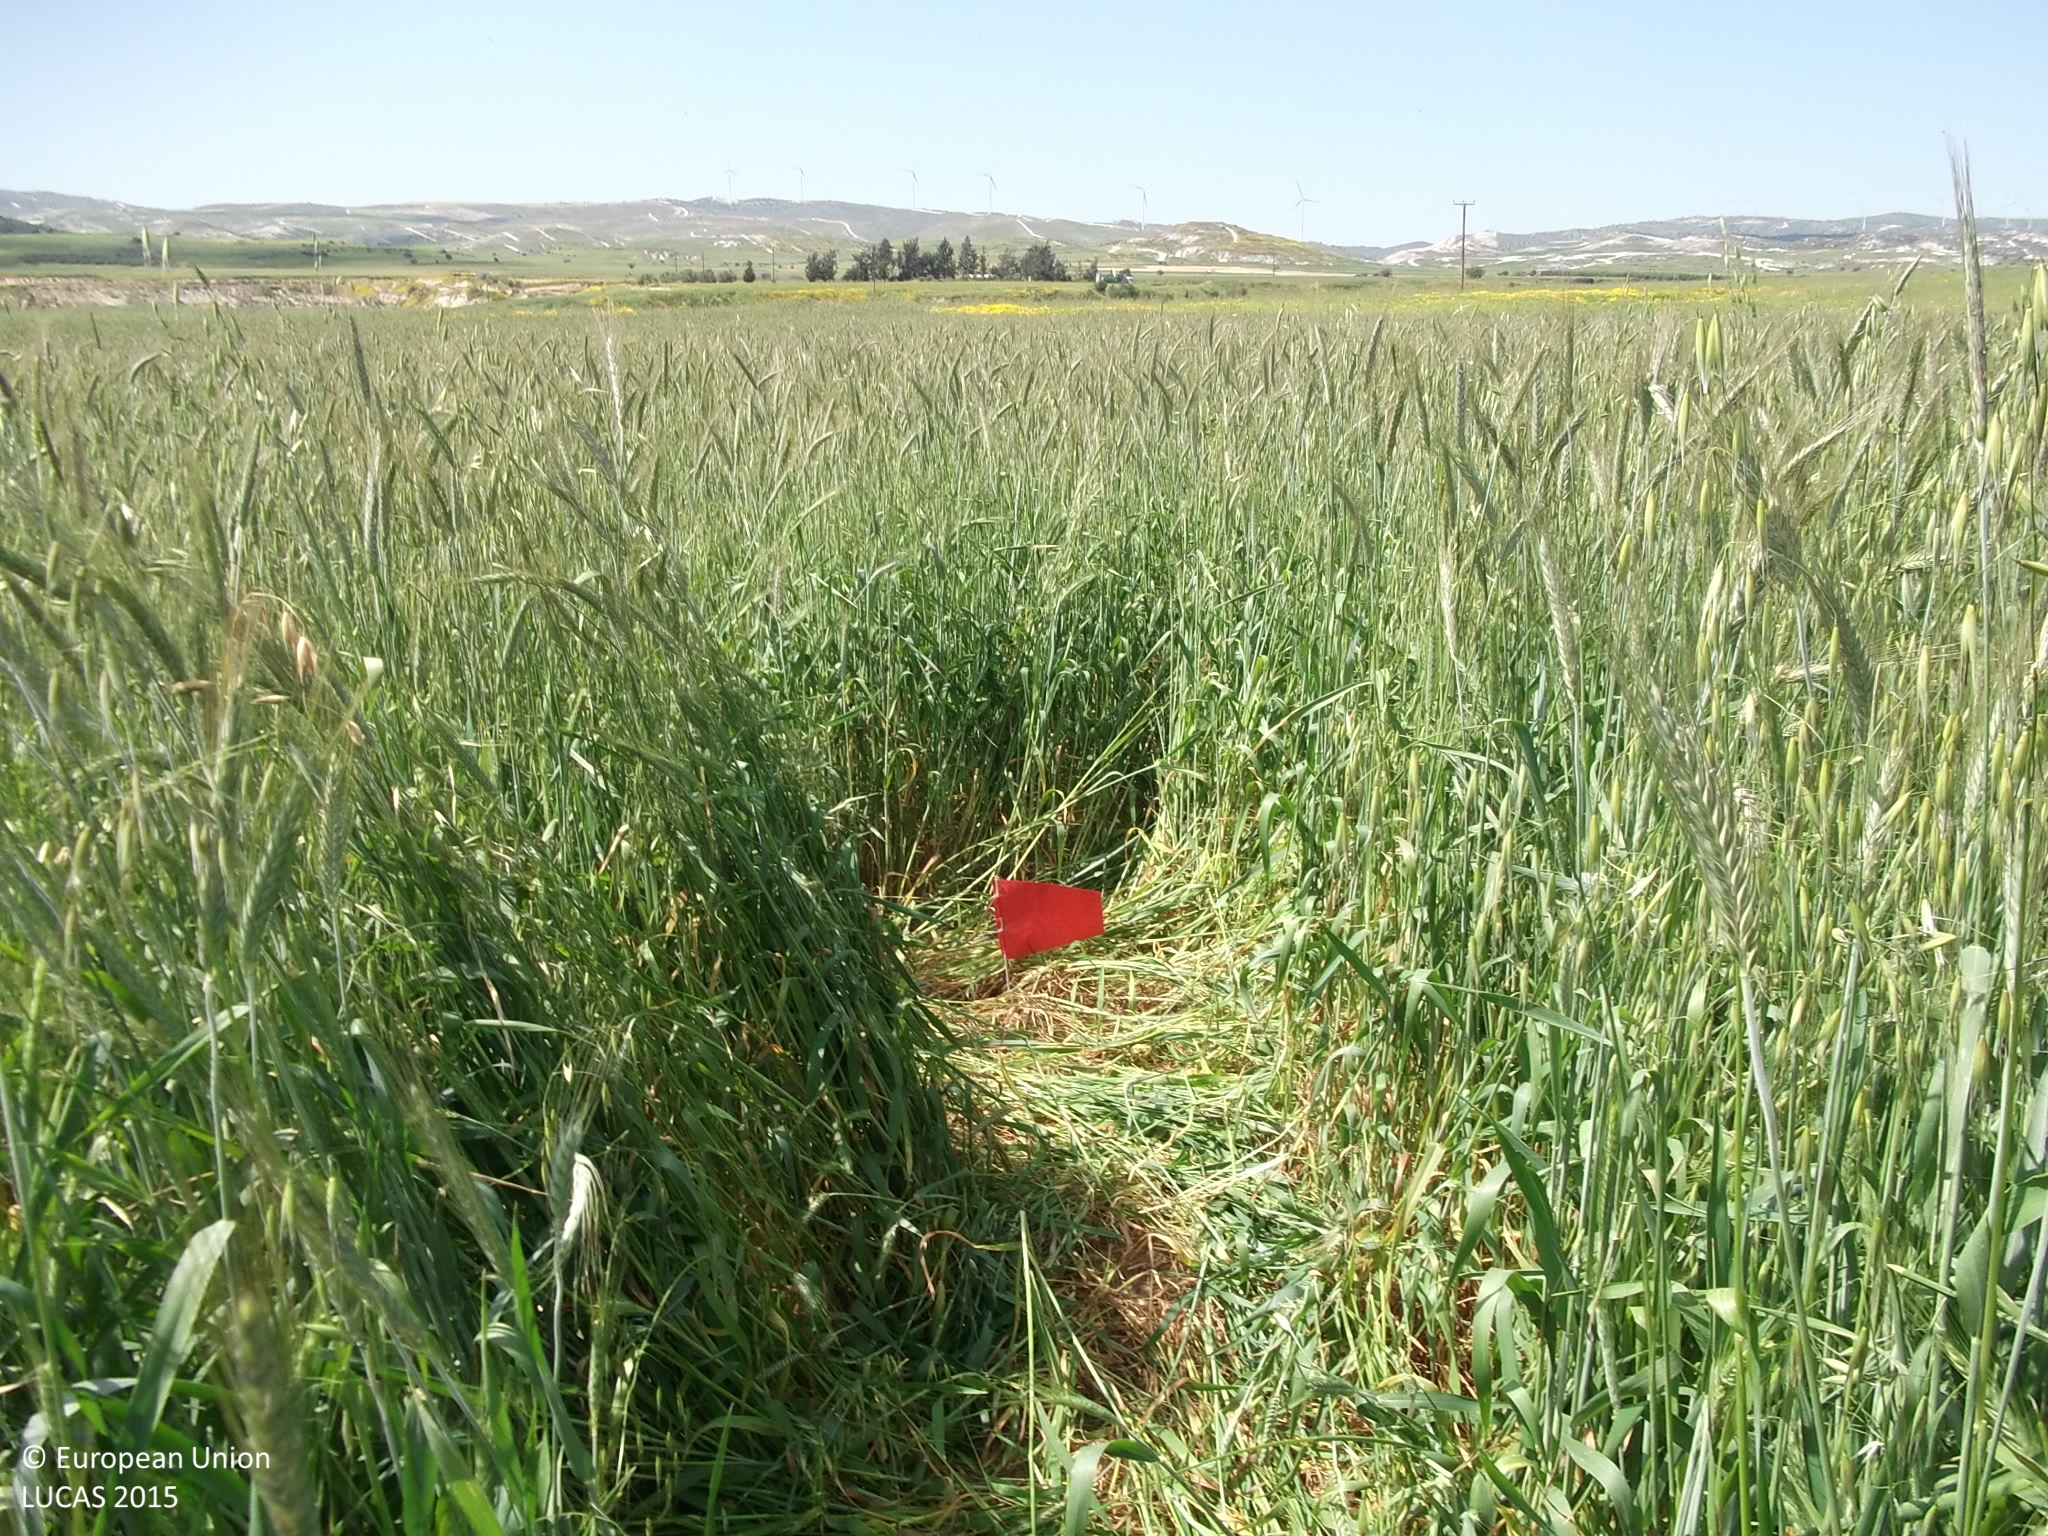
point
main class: Cropland
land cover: Common wheat
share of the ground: > 75 %
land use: Agriculture (excluding fallow land and kitchen gardens)
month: April
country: CY
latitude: 34.8997
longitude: 33.5342
